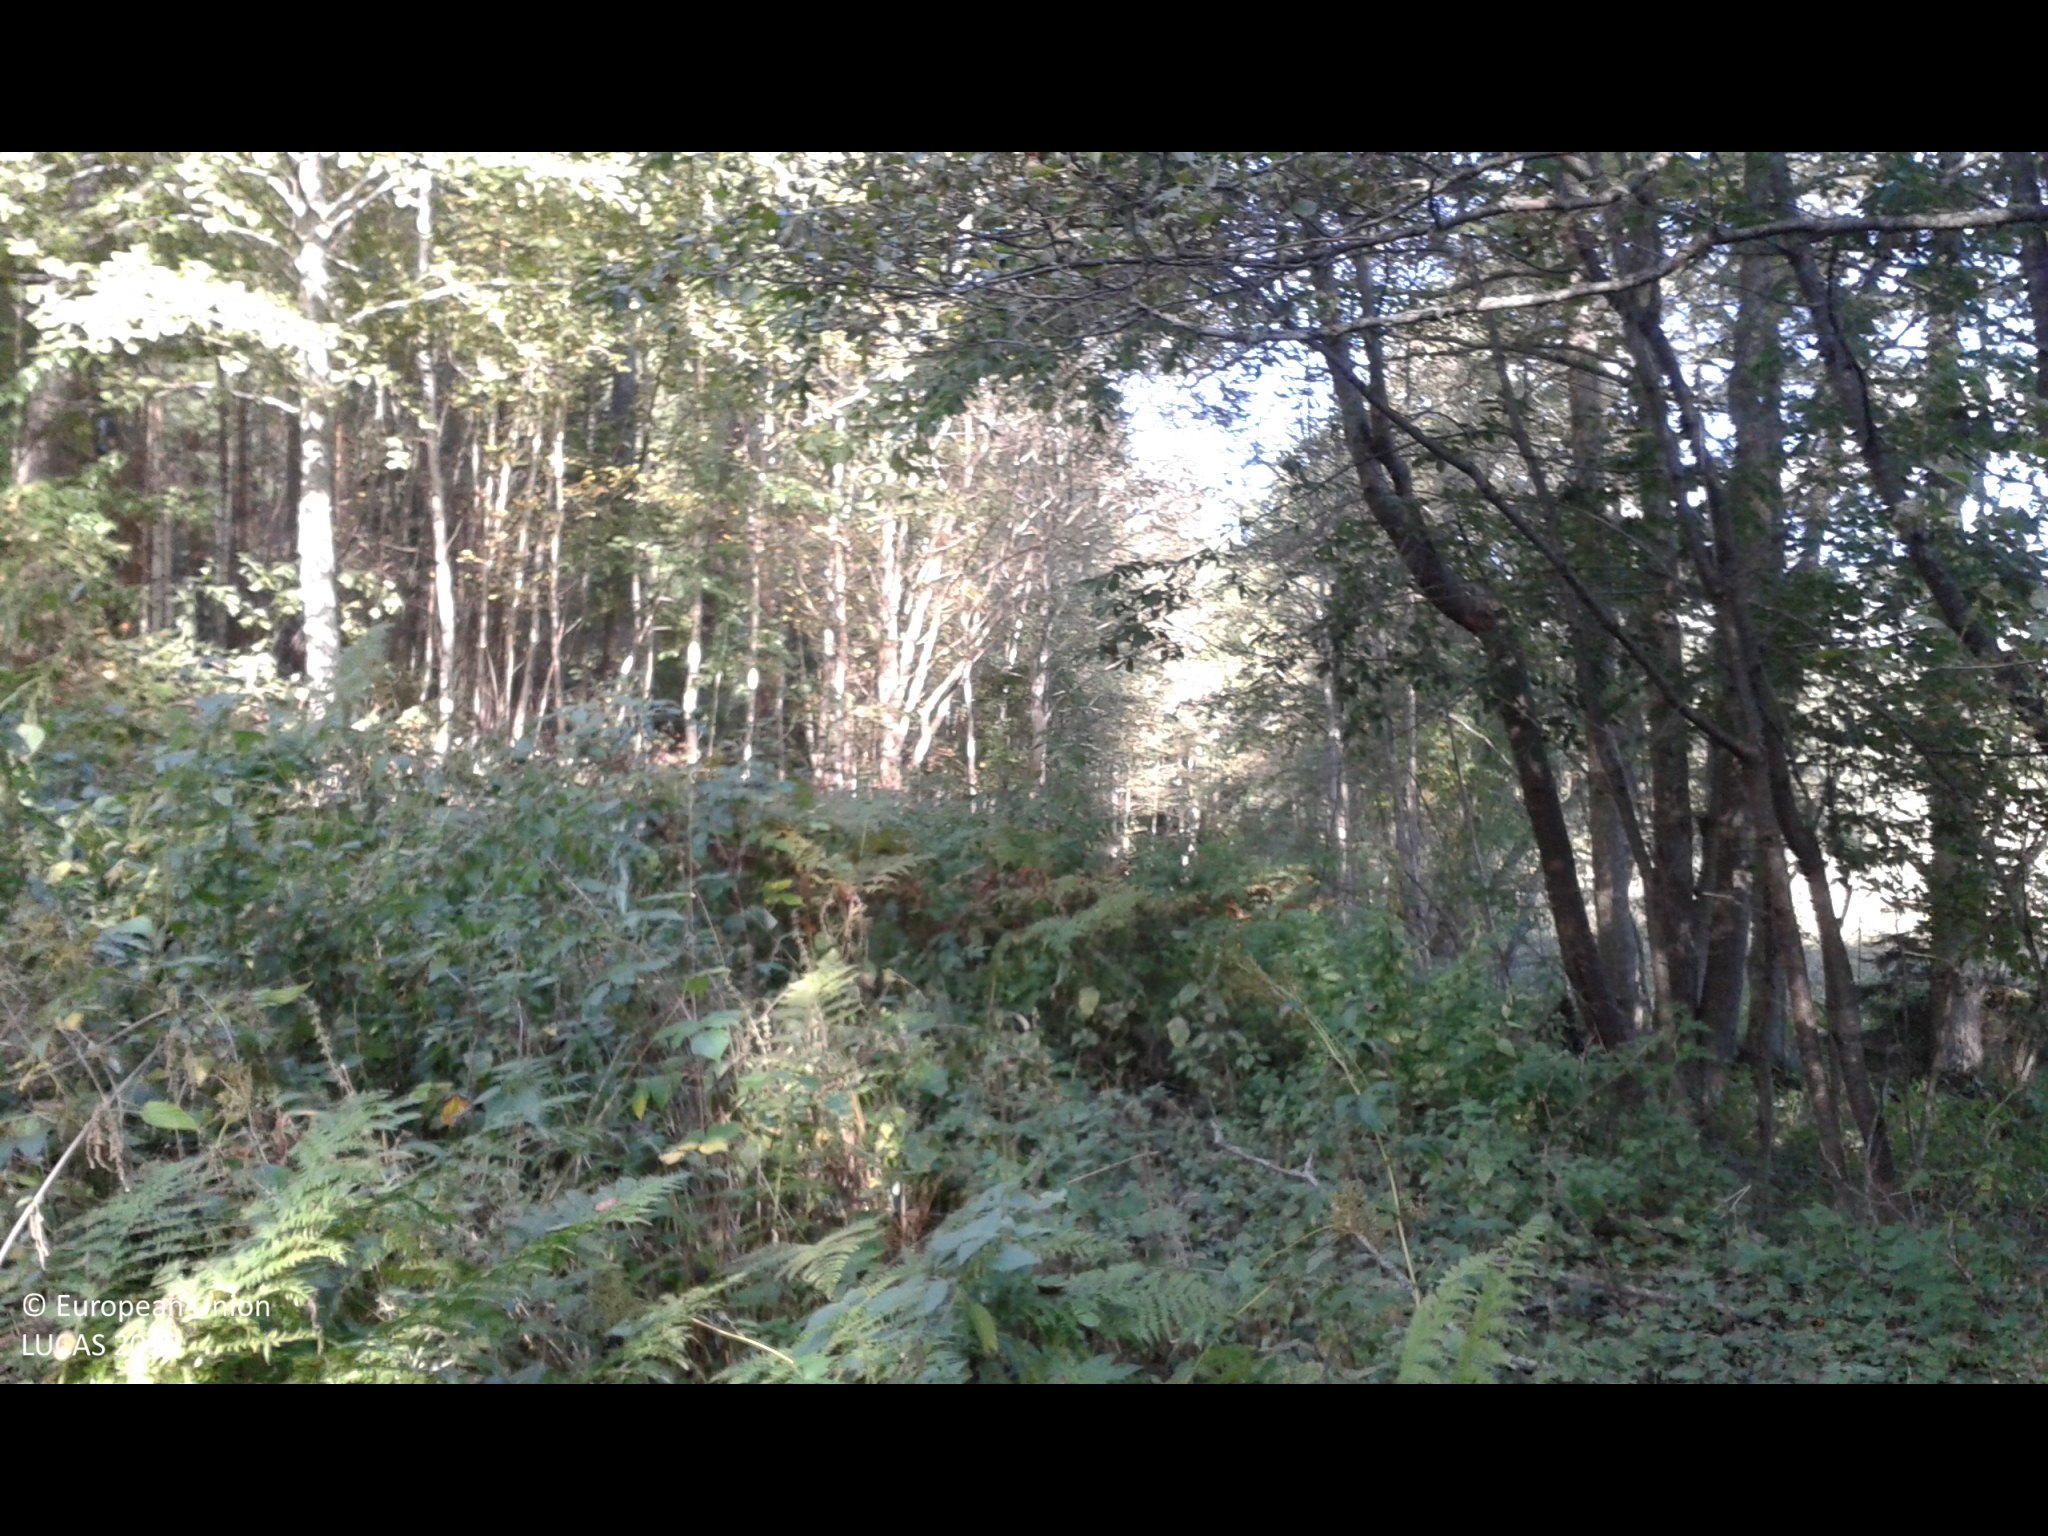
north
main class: Woodland
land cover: Broadleaved woodland
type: hemiboreal forest and nemoral coniferous forest and mixed broadleaved-coniferous forest
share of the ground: > 75 %
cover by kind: broadleaved forest trees 100 %
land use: Amenities, museums, leisure
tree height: > 5 m
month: September
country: SE
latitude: 58.9270
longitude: 17.5892
